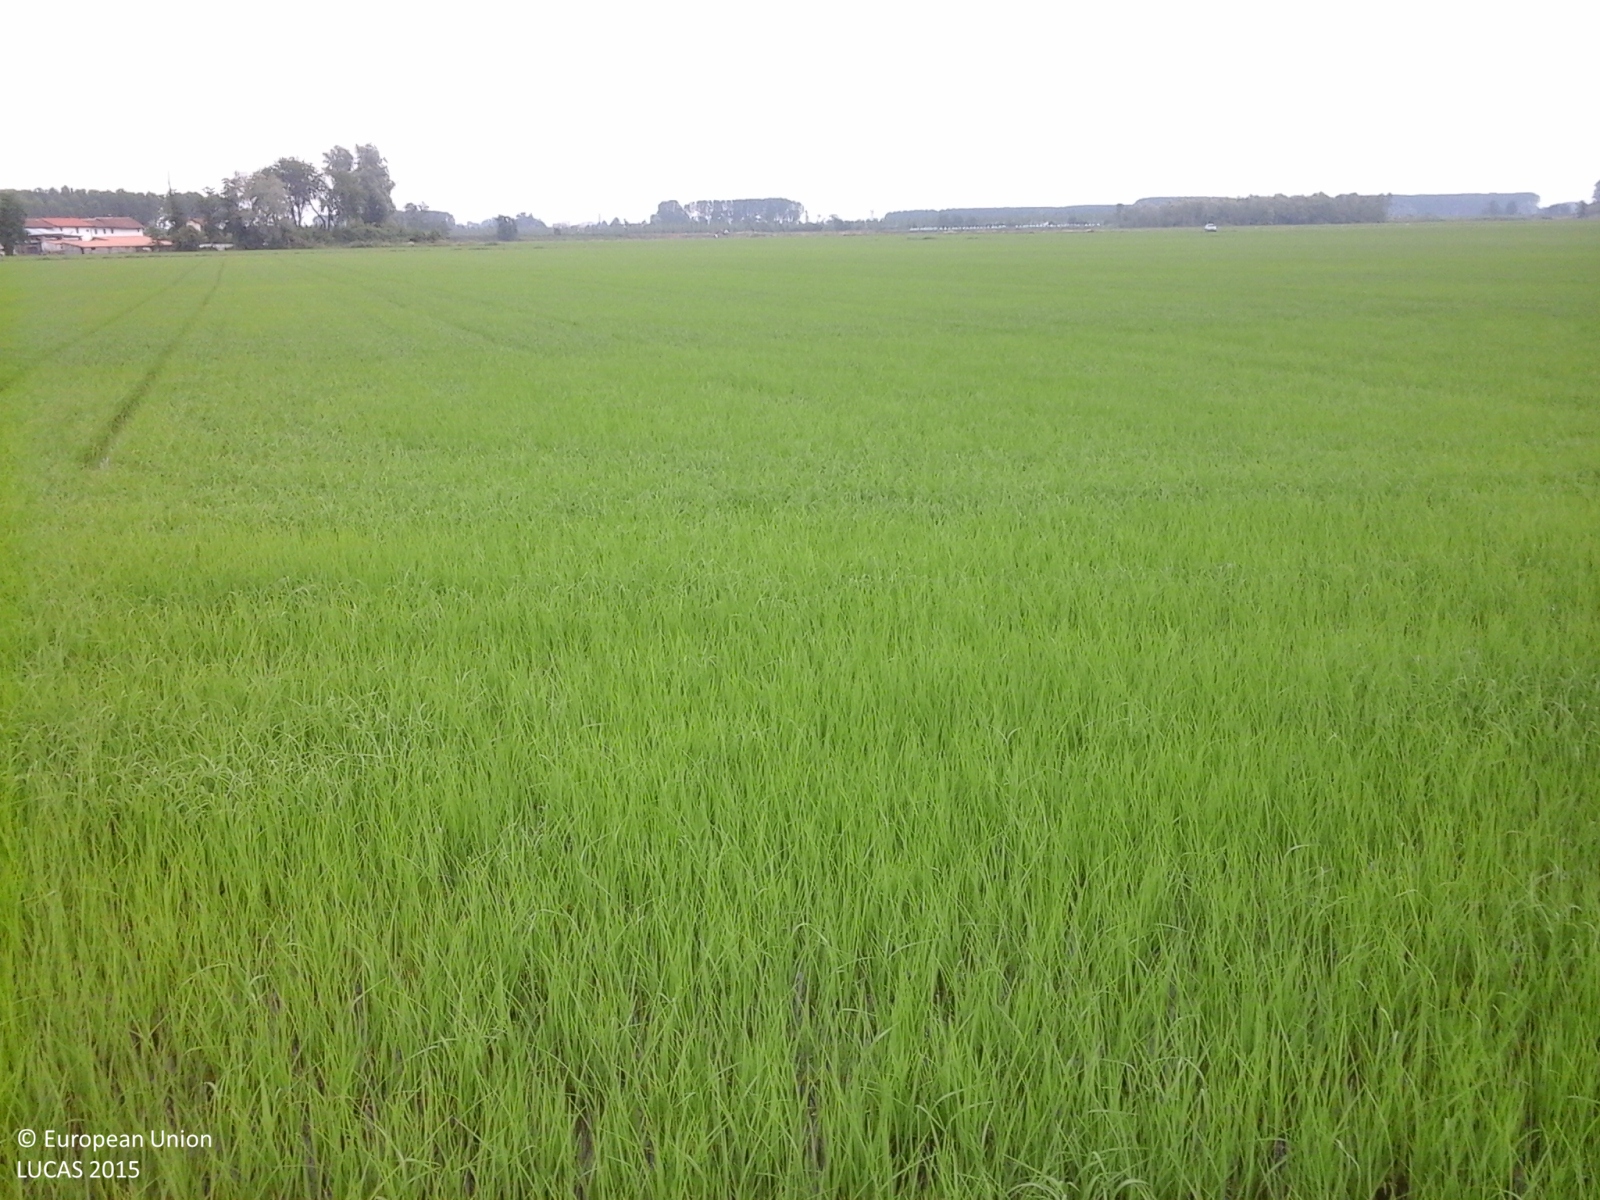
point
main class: Cropland
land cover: Rice
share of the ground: > 75 %
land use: Agriculture (excluding fallow land and kitchen gardens)
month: June
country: IT
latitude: 45.2783
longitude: 8.5620
